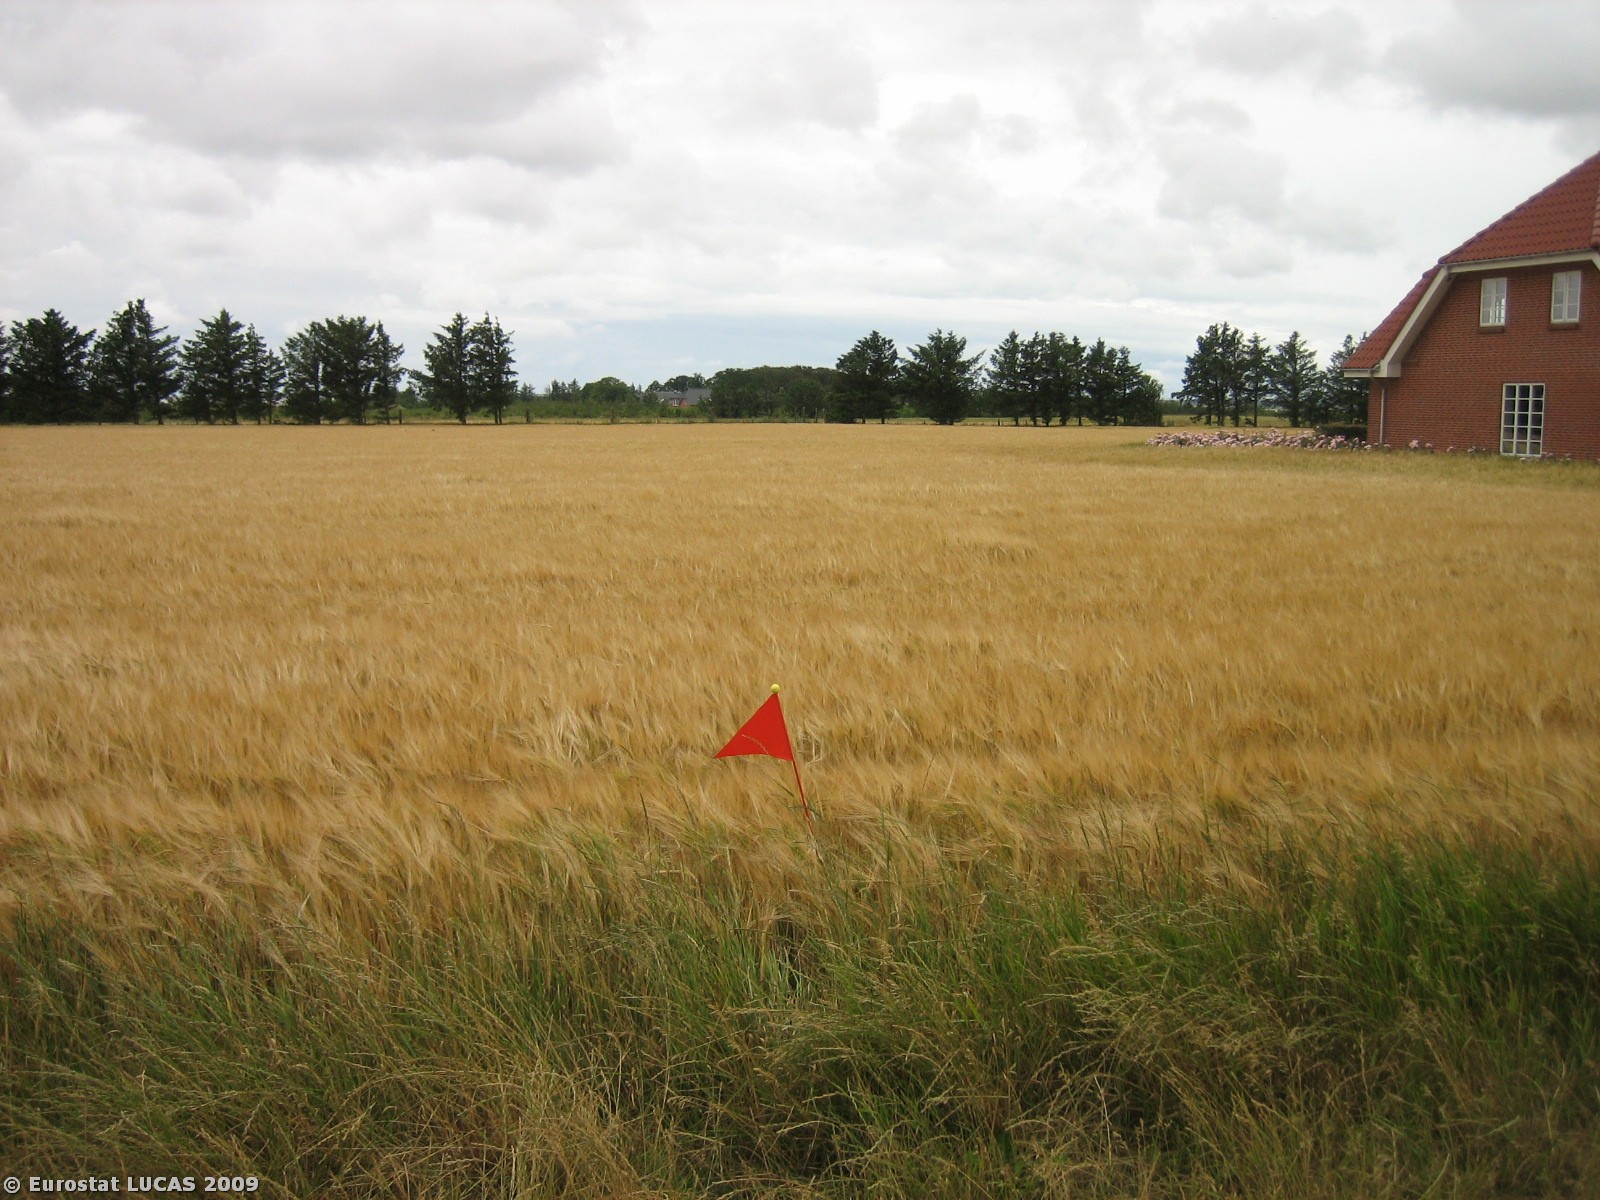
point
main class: Cropland
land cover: Barley
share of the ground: > 75 %
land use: Agriculture (excluding fallow land and kitchen gardens)
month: July
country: DK
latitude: 55.6012
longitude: 8.3033
